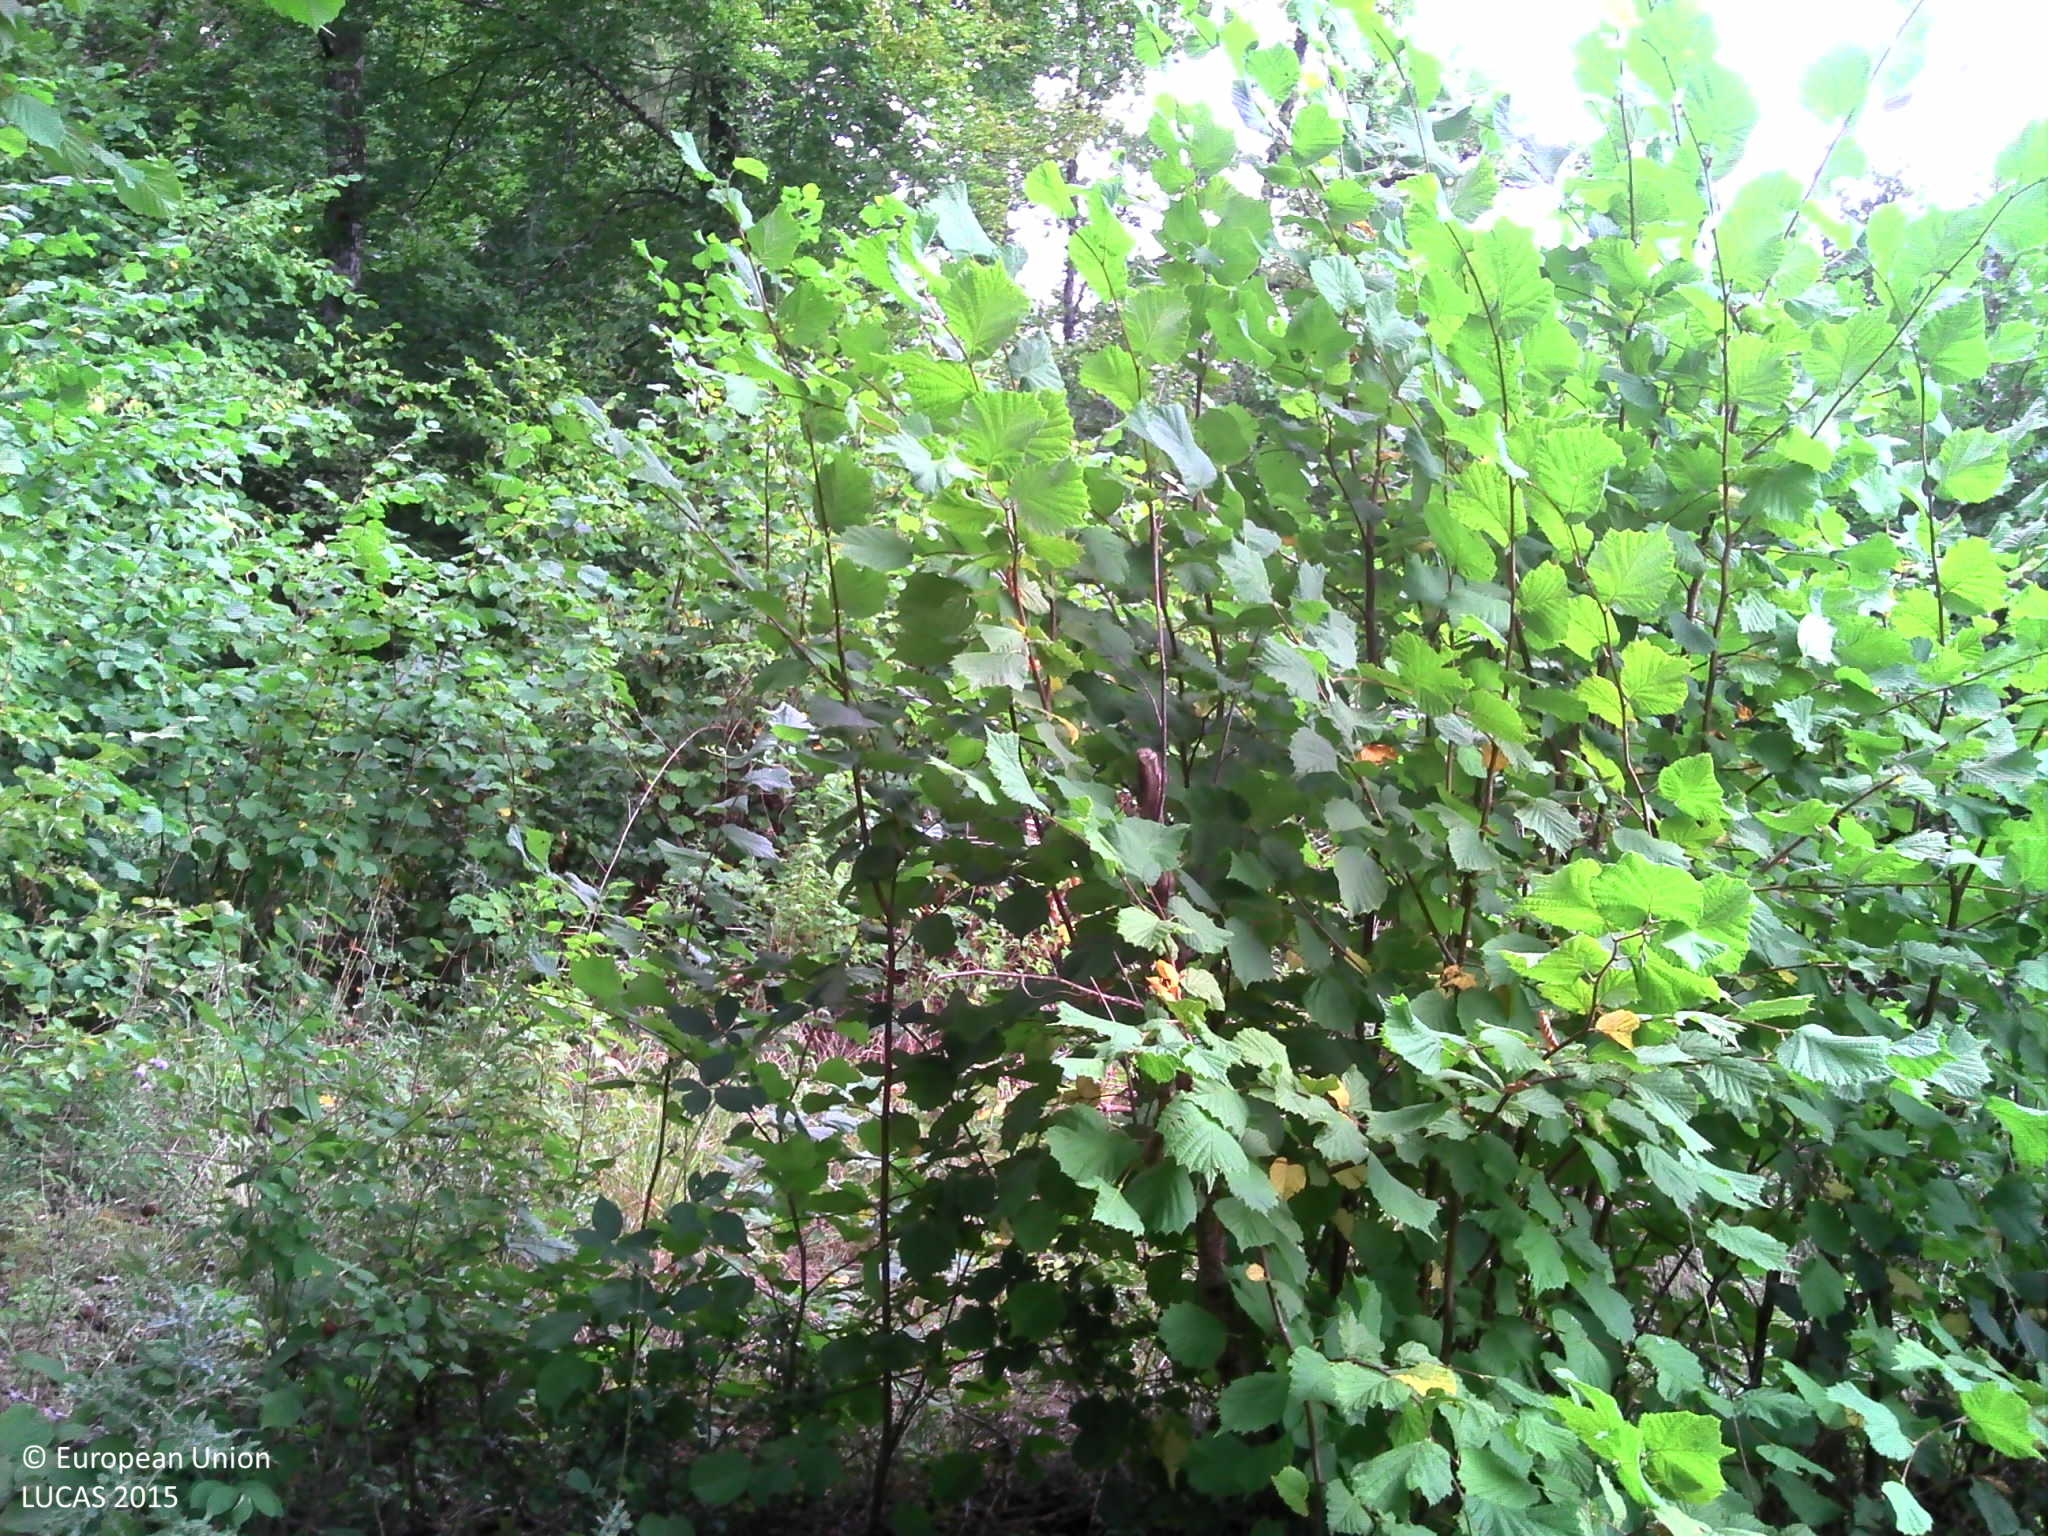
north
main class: Woodland
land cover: Spruce dominated mixed woodland
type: exotic forest
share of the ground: > 75 %
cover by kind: broadleaved forest trees 55 %, coniferous forest trees 30 %, herbaceous plants 10 %, lichens and mosses 5 %
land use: Forestry
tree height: > 5 m
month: August
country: FR
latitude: 47.7382
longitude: 4.7583
